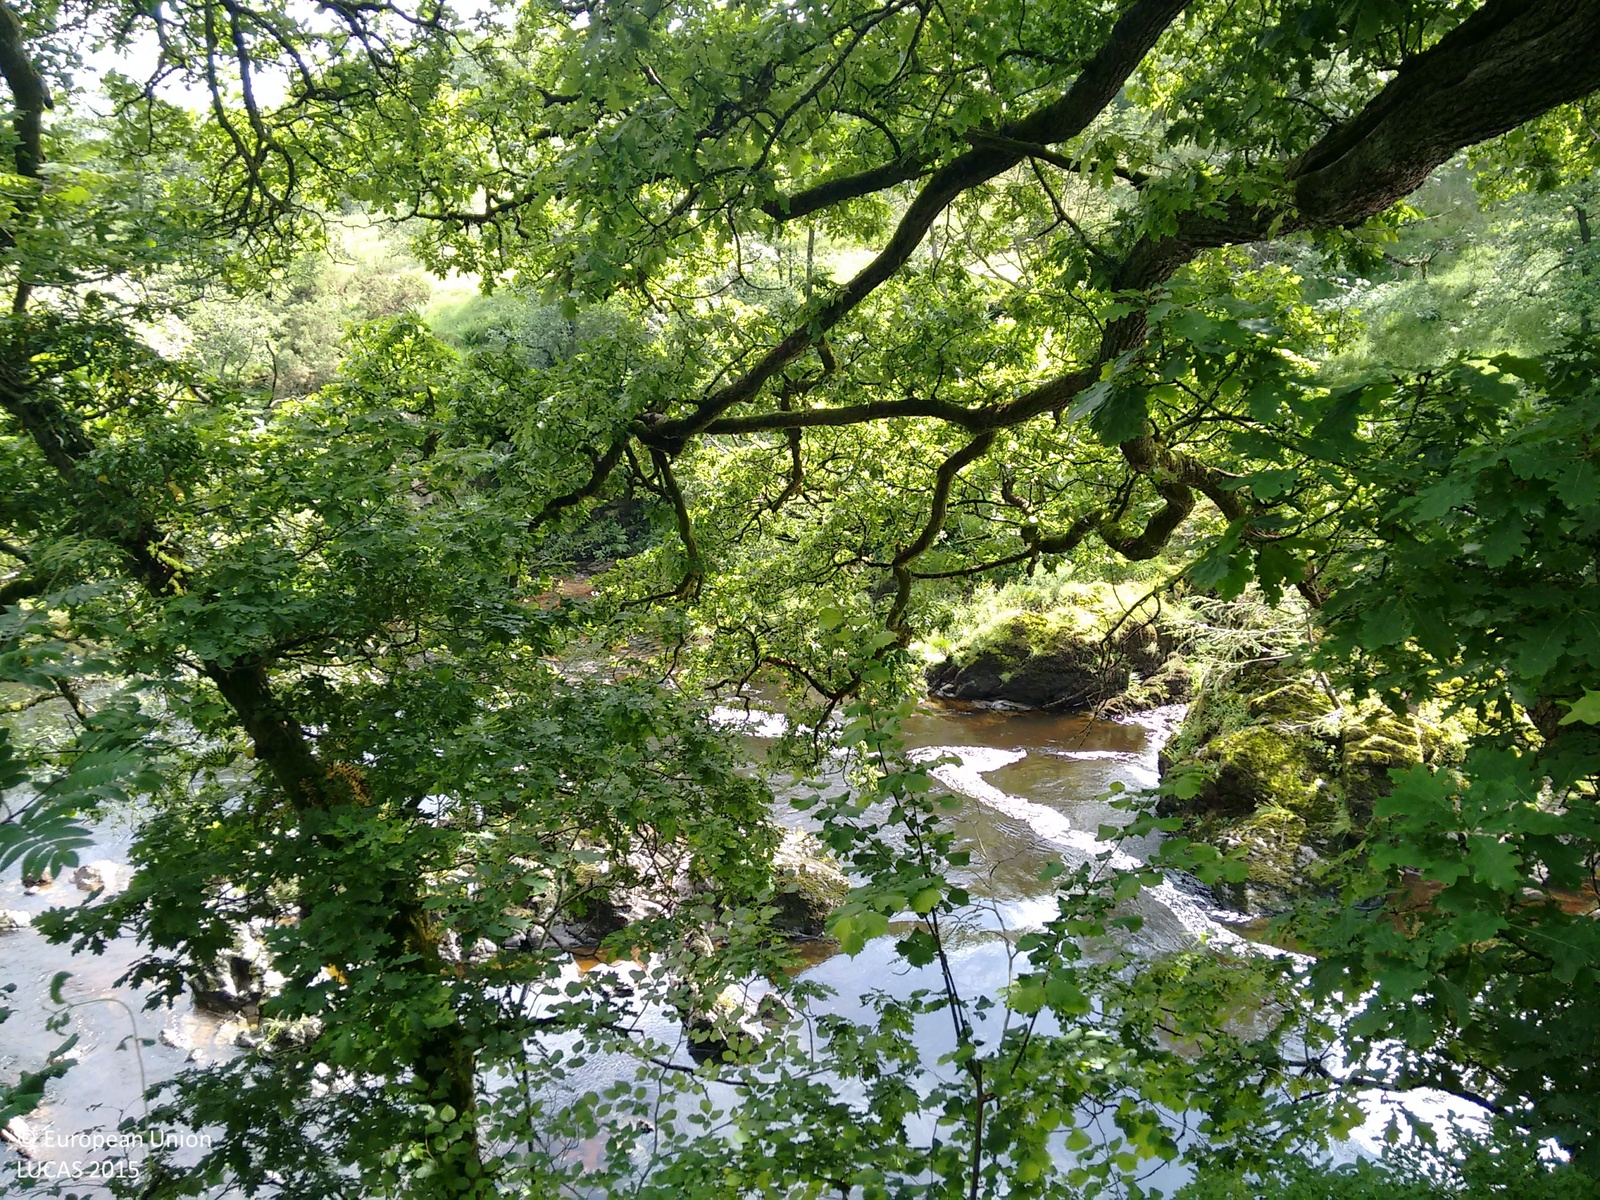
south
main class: Woodland
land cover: Broadleaved woodland
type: acidophilous oak and oak-birch forest
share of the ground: > 75 %
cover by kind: broadleaved forest trees 100 %
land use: Semi-natural and natural areas not in use
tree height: > 5 m
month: July
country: GB
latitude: 55.3261
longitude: -3.8139
